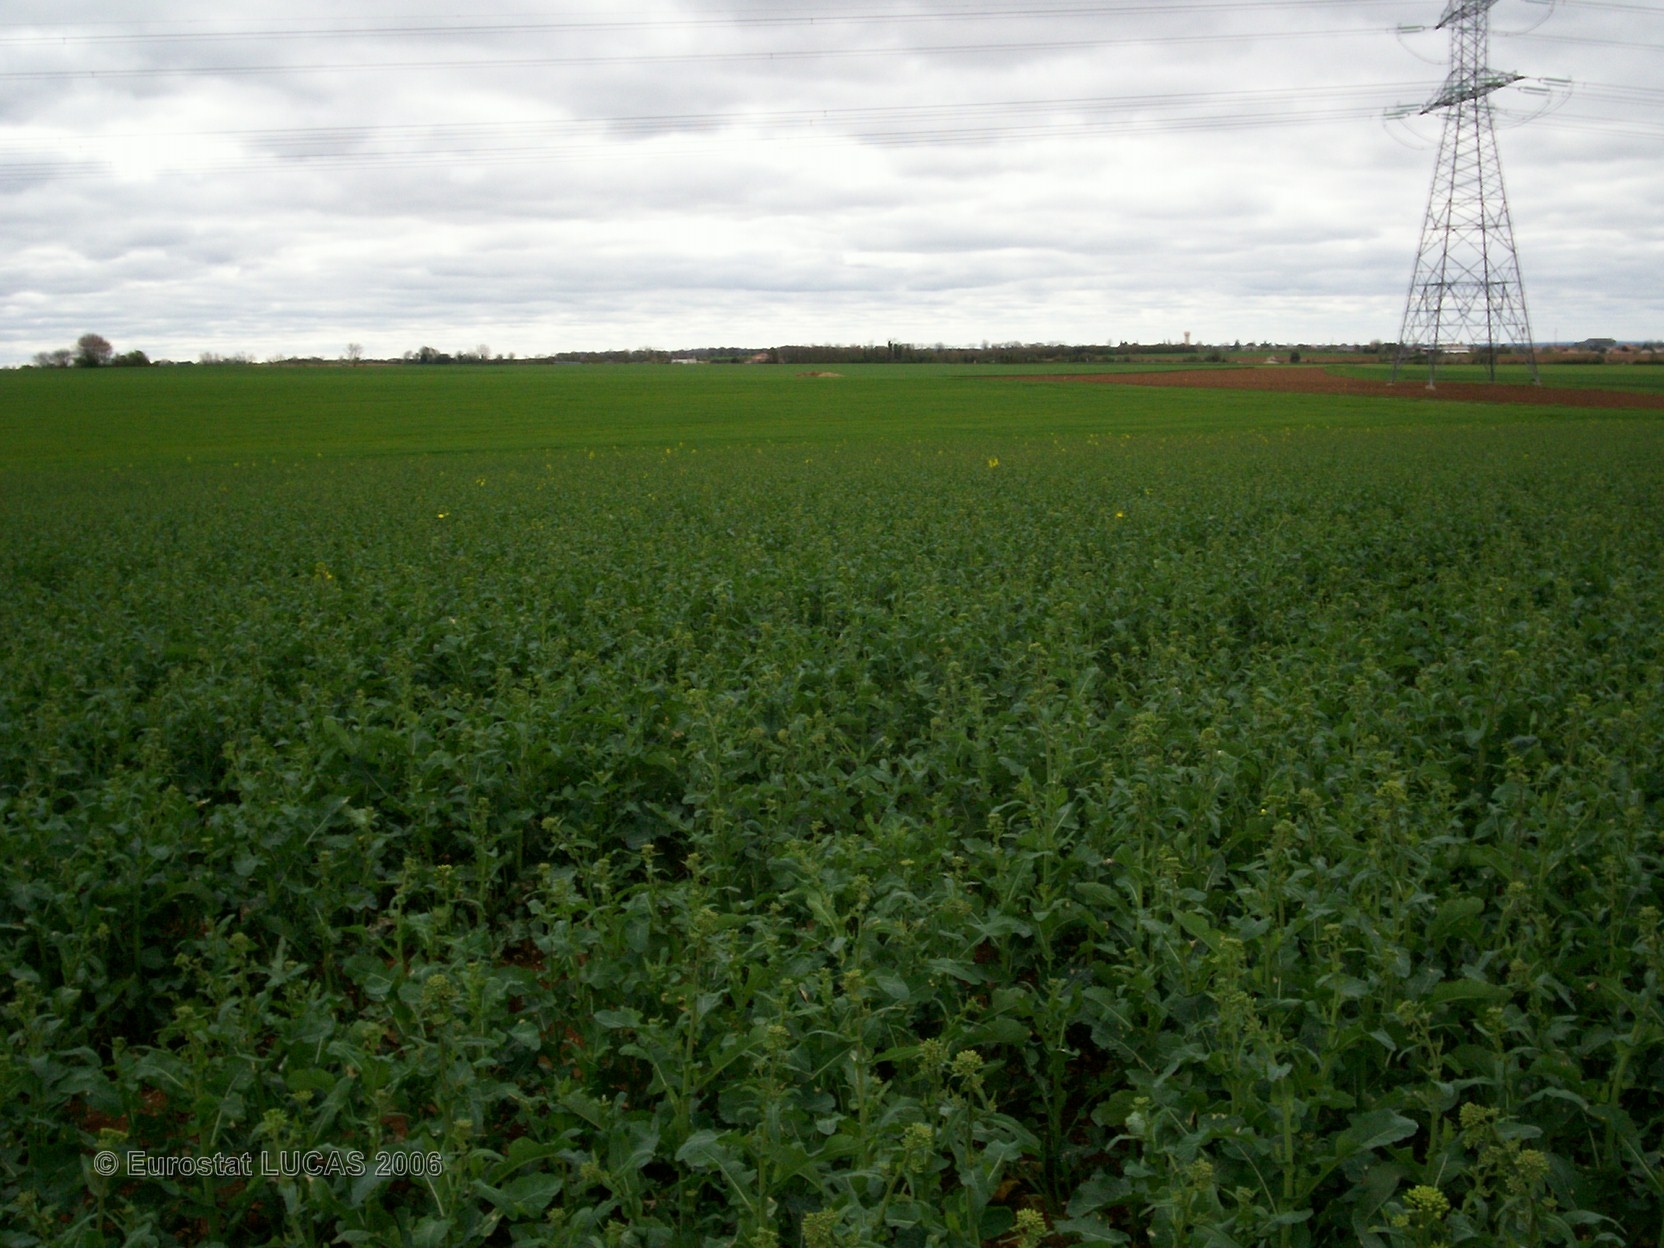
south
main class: Cropland
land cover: Rape and turnip rape
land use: Agriculture (excluding fallow land and kitchen gardens)
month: April
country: FR
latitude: 46.2738
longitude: -0.2616
